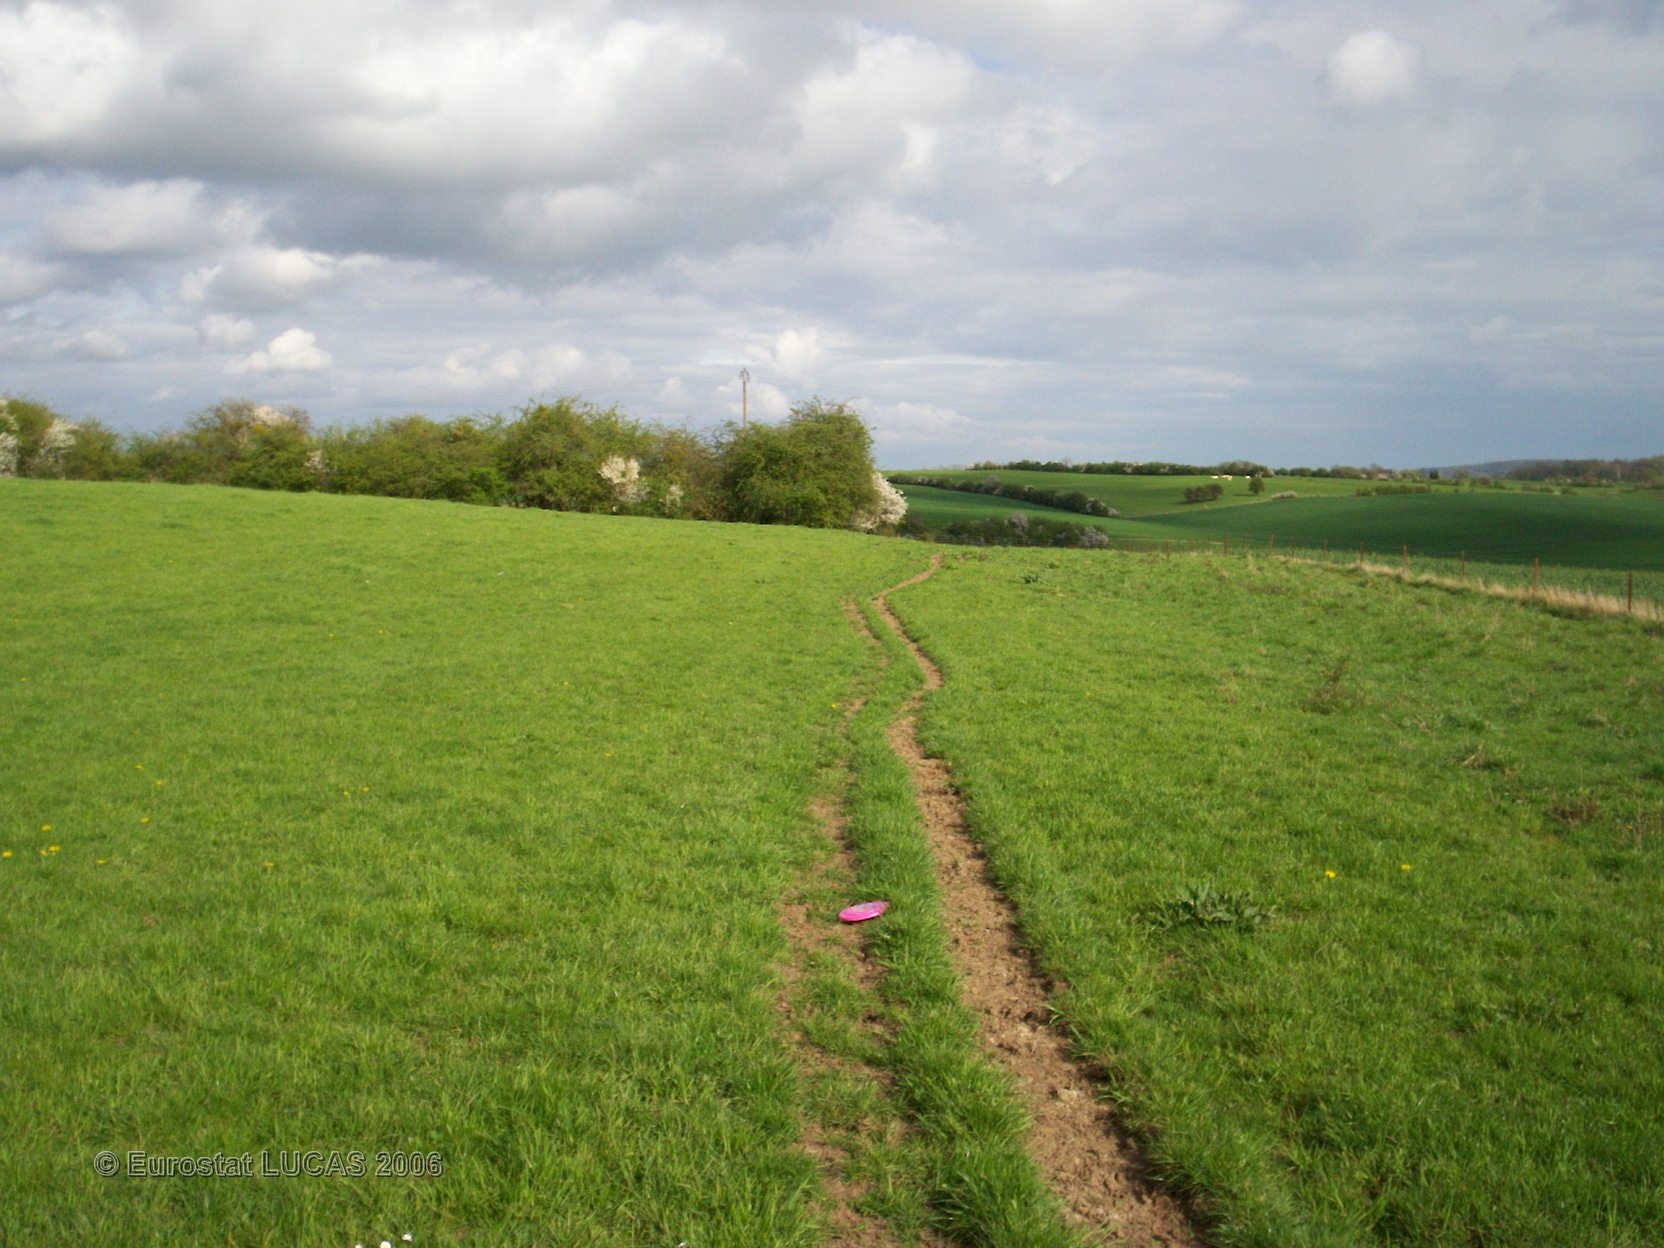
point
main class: Grassland
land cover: Grassland without tree/shrub cover
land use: Agriculture (excluding fallow land and kitchen gardens)
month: April
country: FR
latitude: 49.6754
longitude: 4.5502
